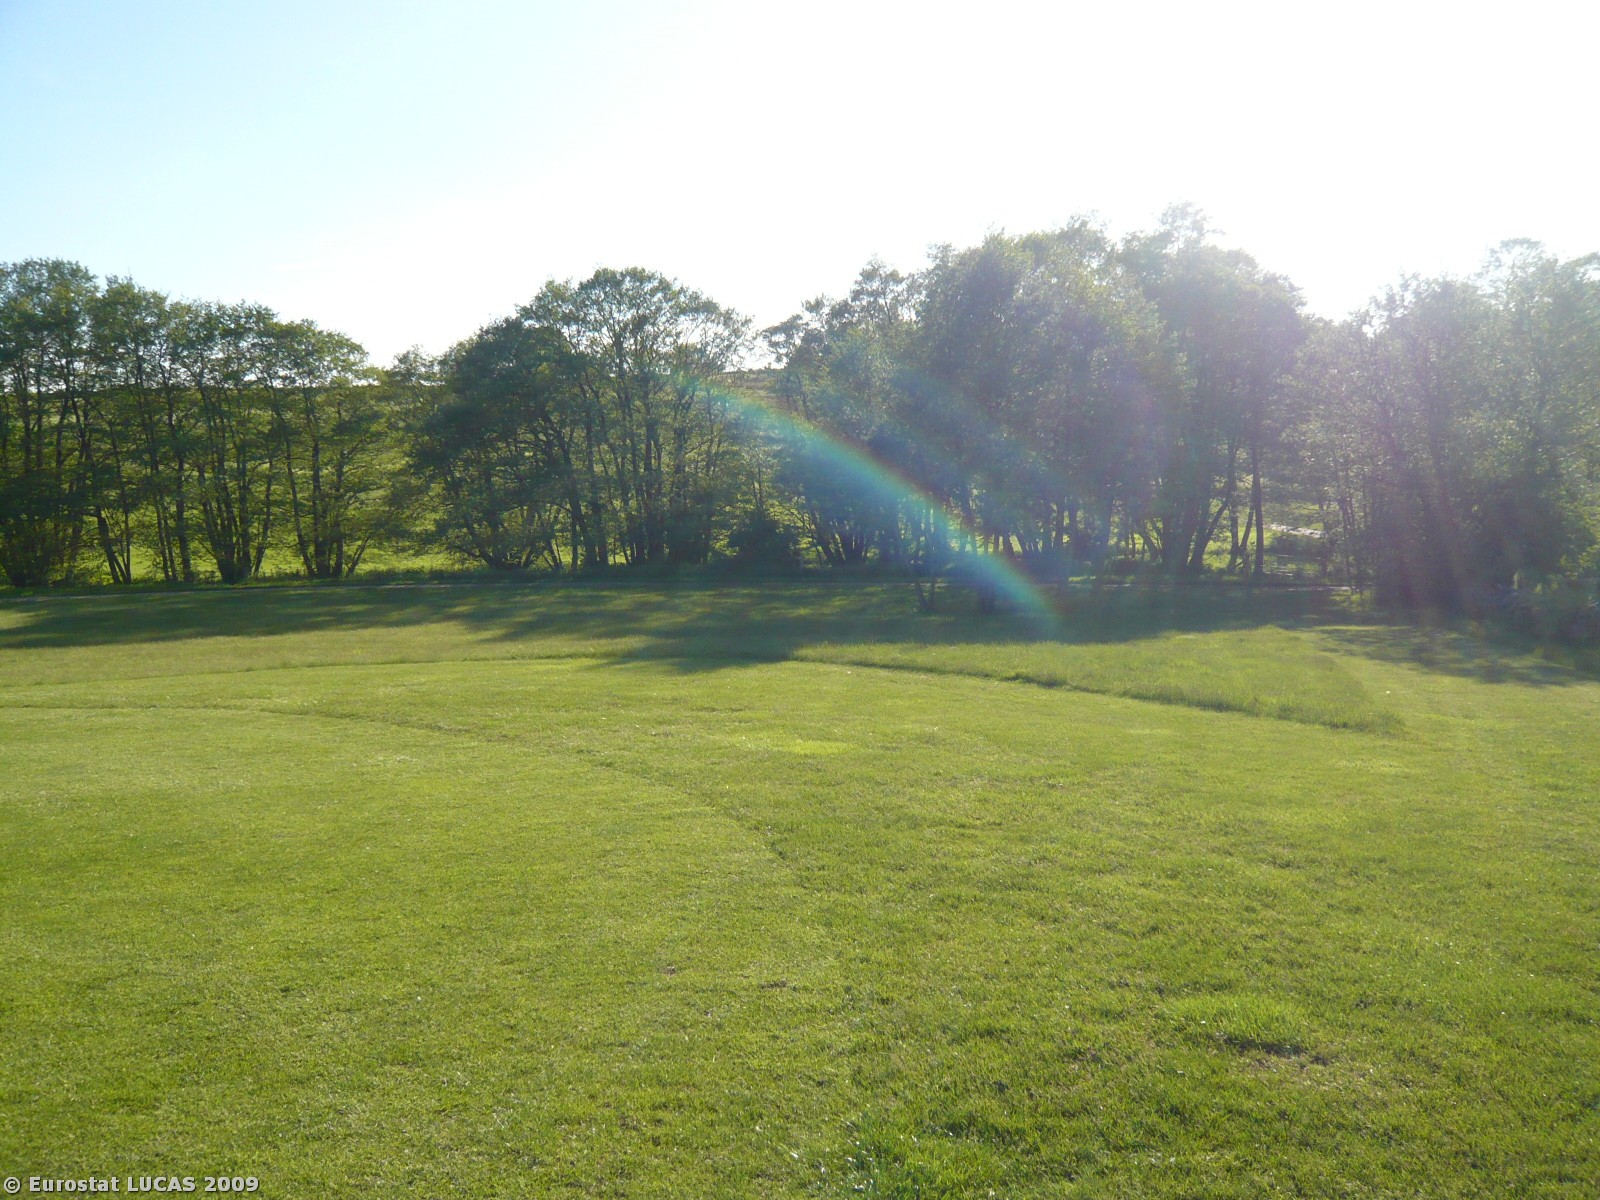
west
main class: Grassland
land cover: Grassland without tree/shrub cover
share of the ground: > 75 %
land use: Sport
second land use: Amenities, museums, leisure
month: May
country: DK
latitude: 55.3872
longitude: 11.5615
